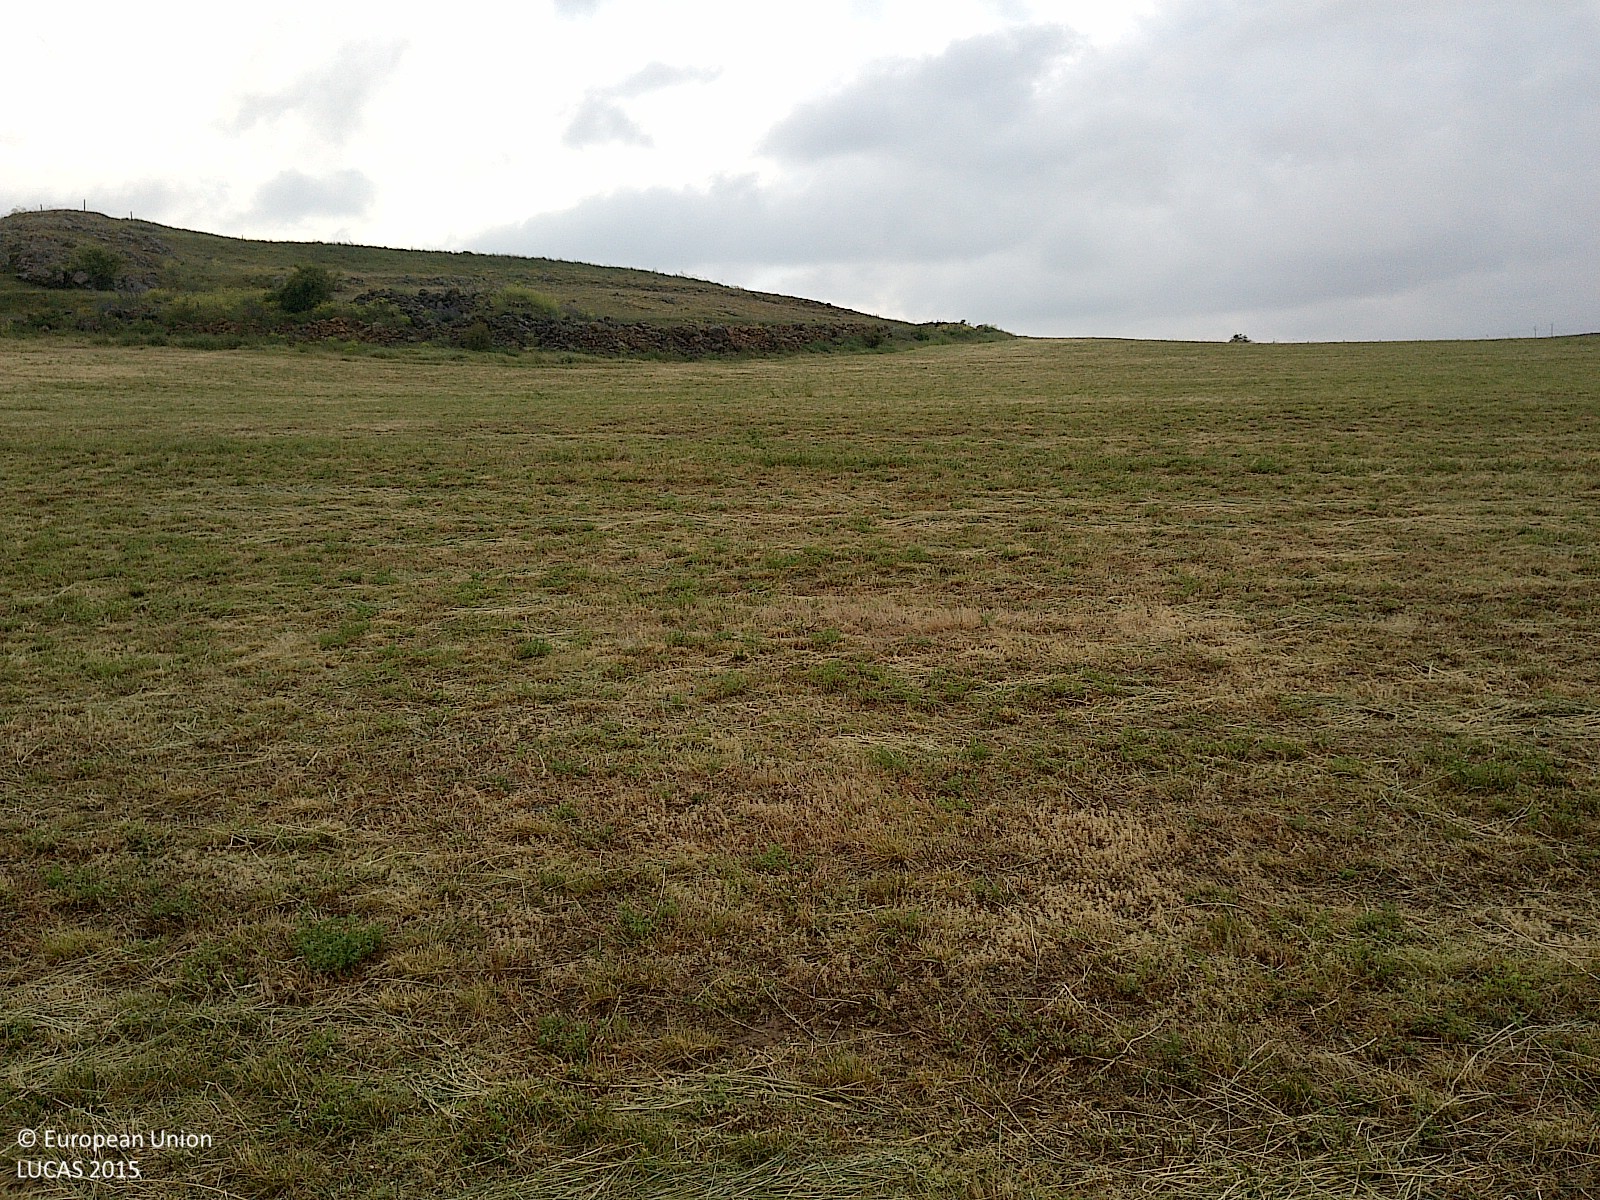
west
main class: Cropland
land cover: Lucerne
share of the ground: > 75 %
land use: Agriculture (excluding fallow land and kitchen gardens)
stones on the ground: < 10 %
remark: Harvested field
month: May
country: ES
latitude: 41.7622
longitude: -2.2440
